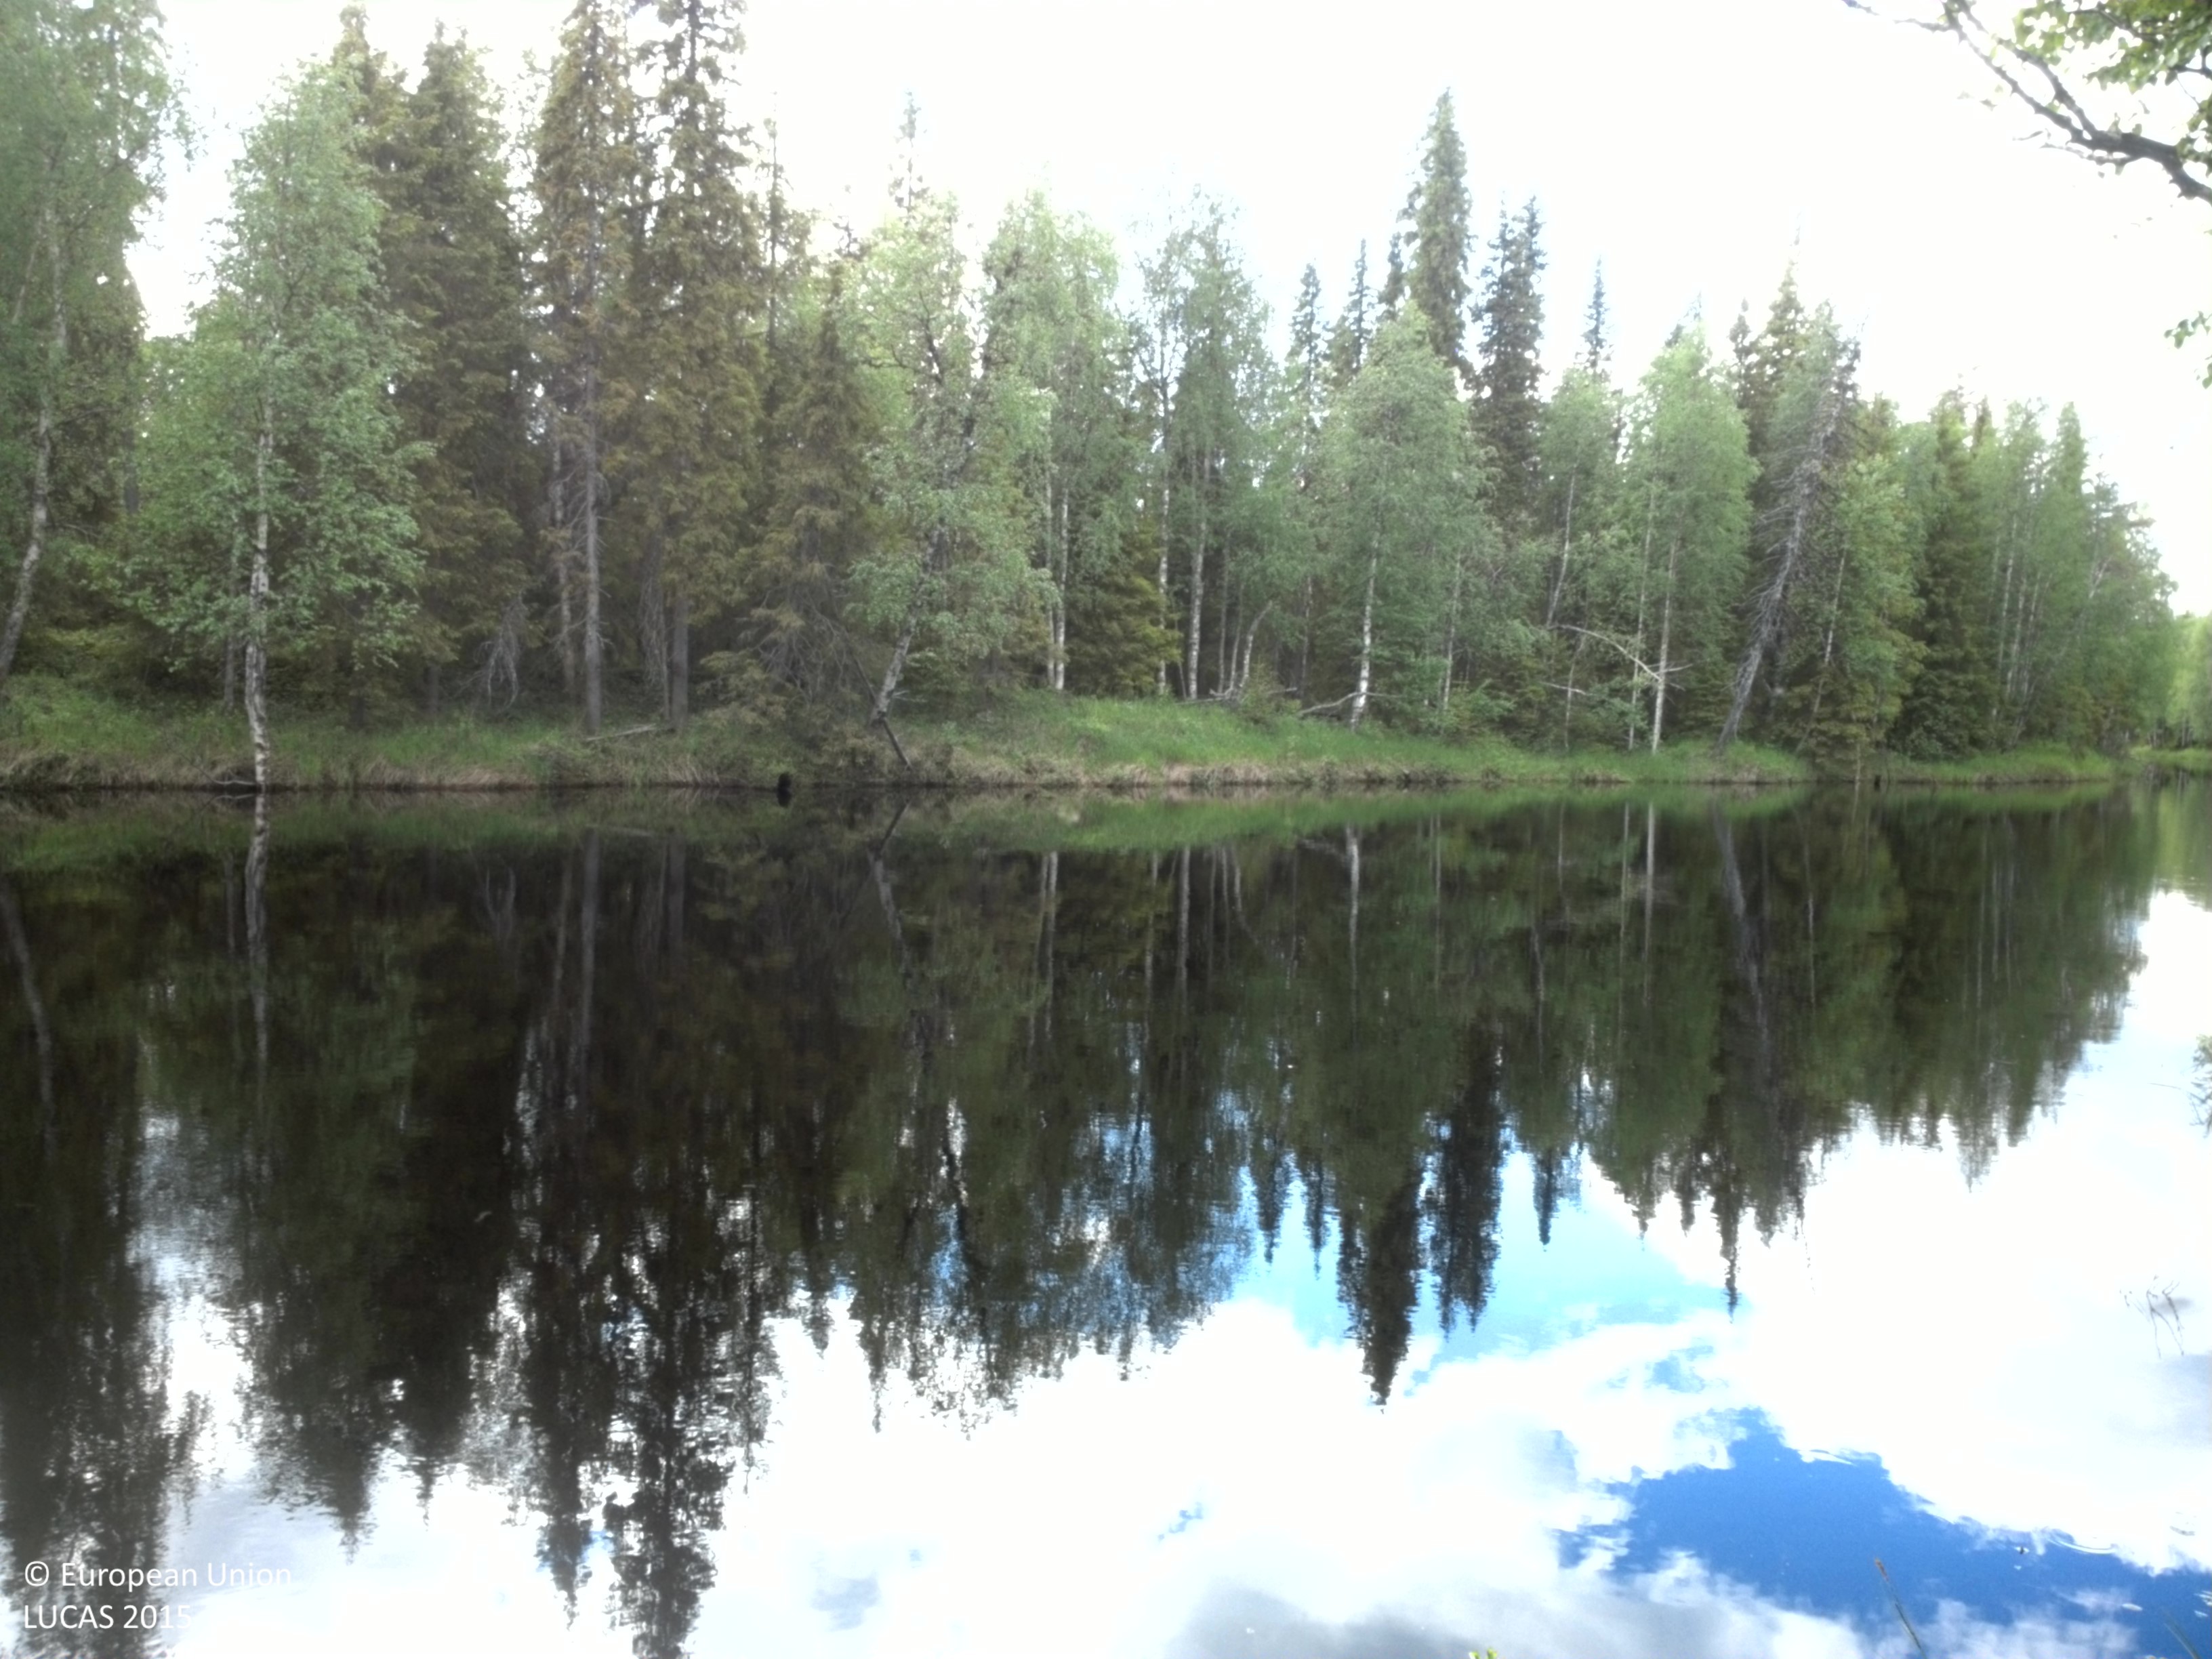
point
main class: Woodland
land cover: Spruce dominated mixed woodland
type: boreal forest
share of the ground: 50 - 75 %
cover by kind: shrubs 40 %, coniferous forest trees 35 %, broadleaved forest trees 25 %
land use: Forestry
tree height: > 5 m
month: June
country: SE
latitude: 66.4264
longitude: 22.3628
